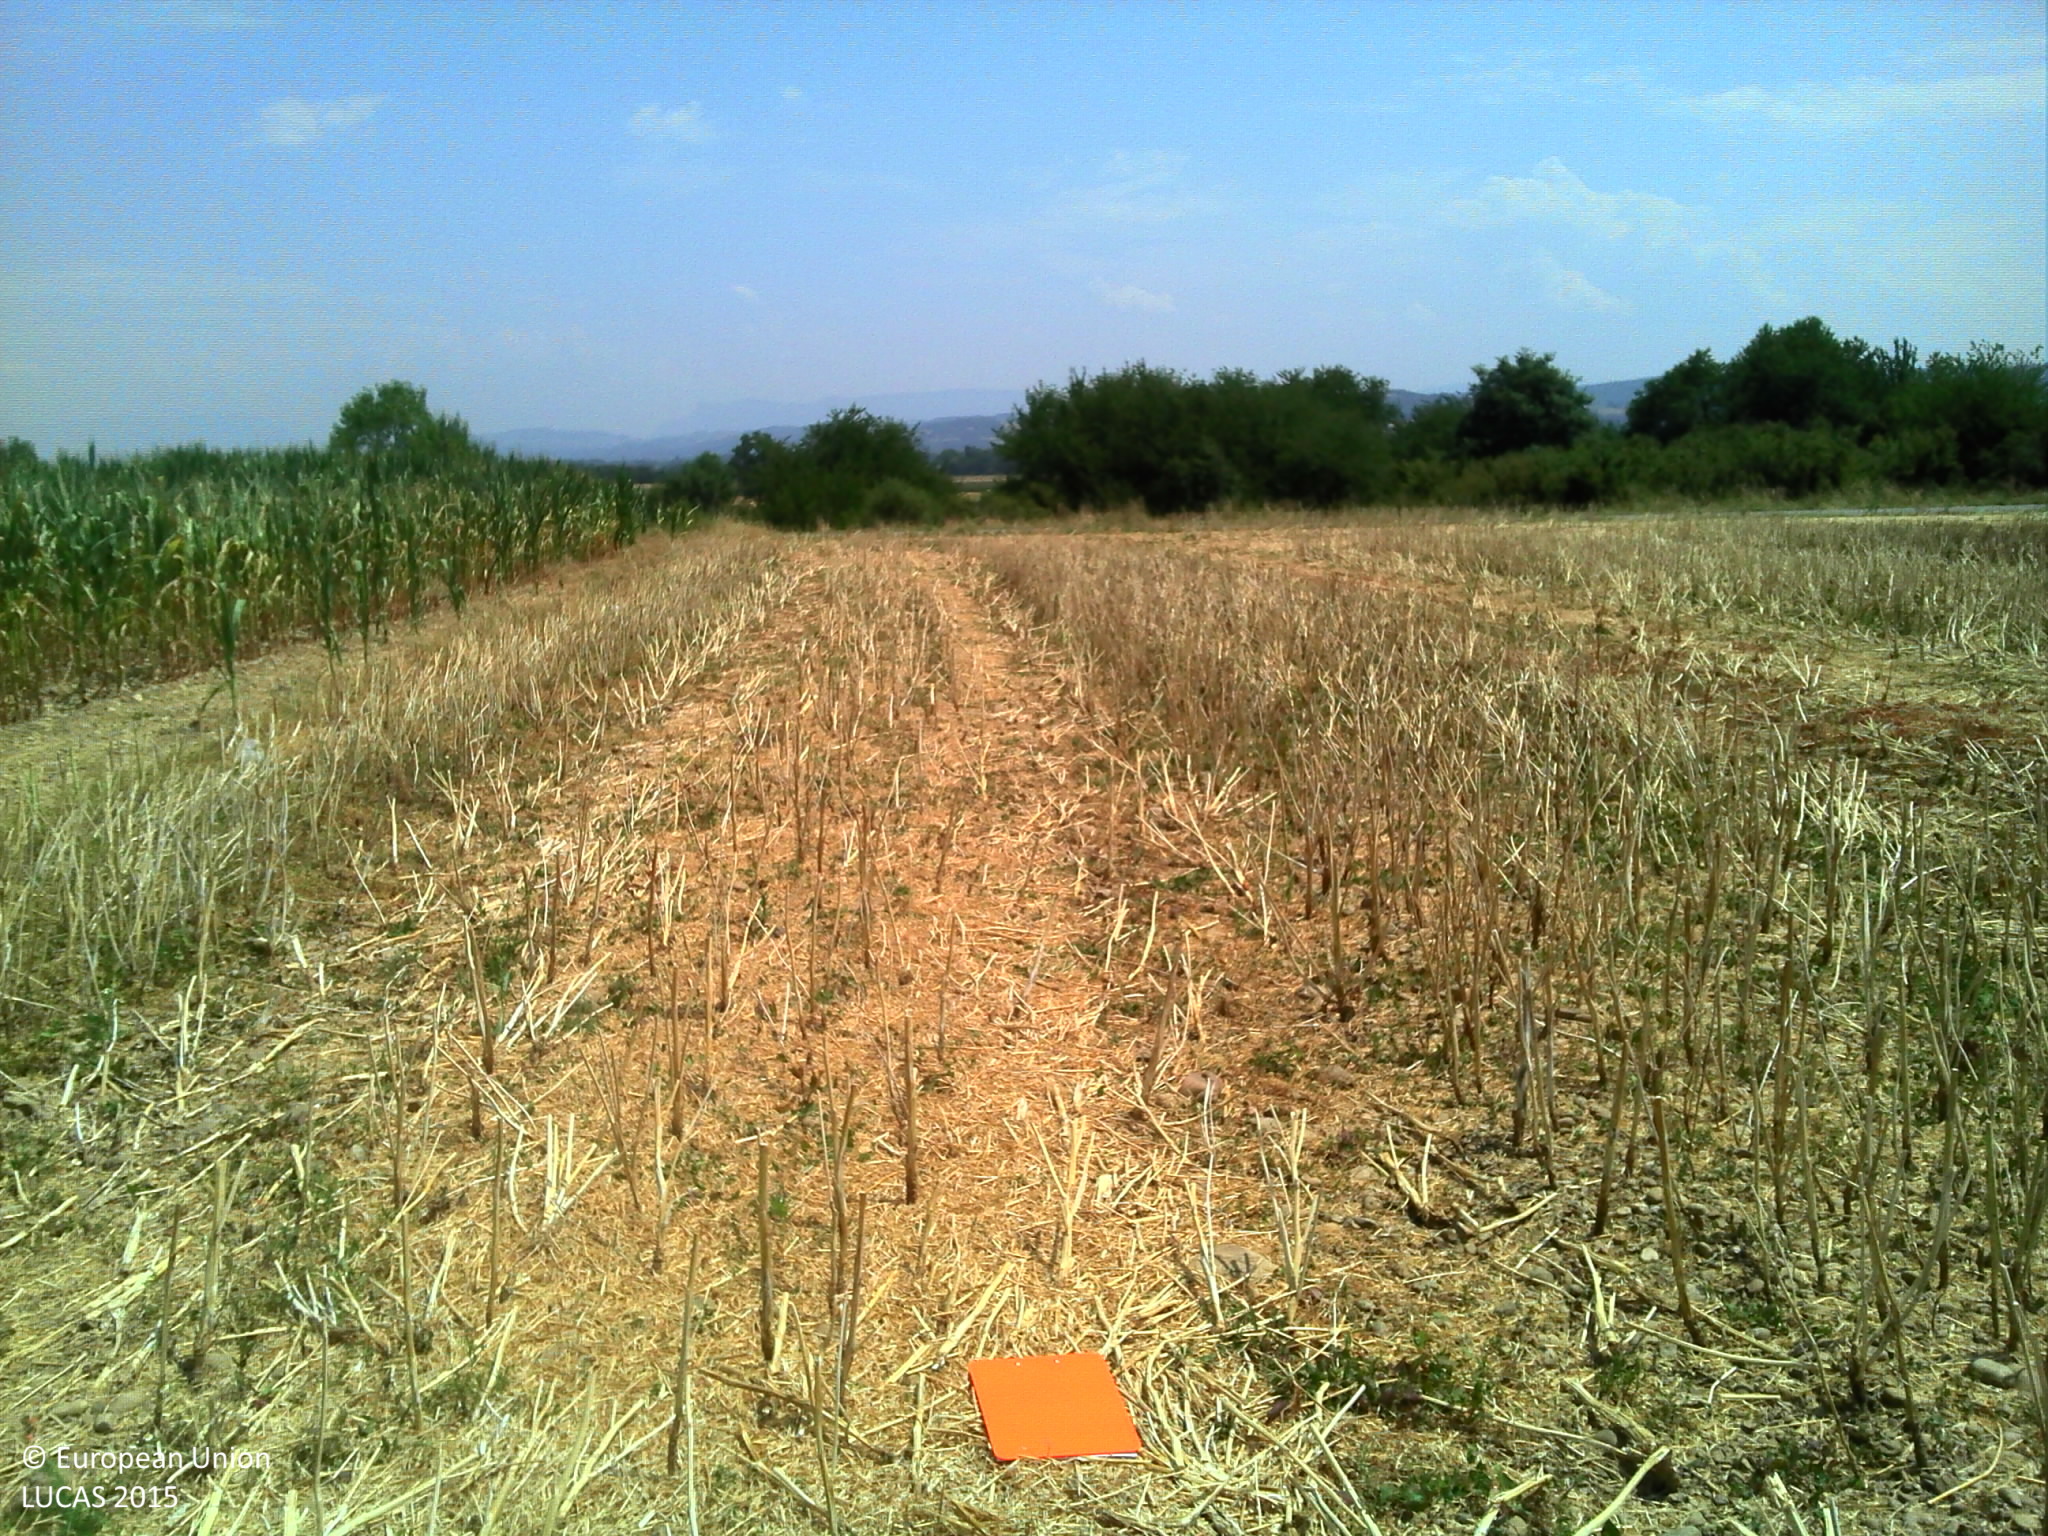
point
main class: Cropland
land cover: Rape and turnip rape
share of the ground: > 75 %
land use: Agriculture (excluding fallow land and kitchen gardens)
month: July
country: FR
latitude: 45.3588
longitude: 5.1921
